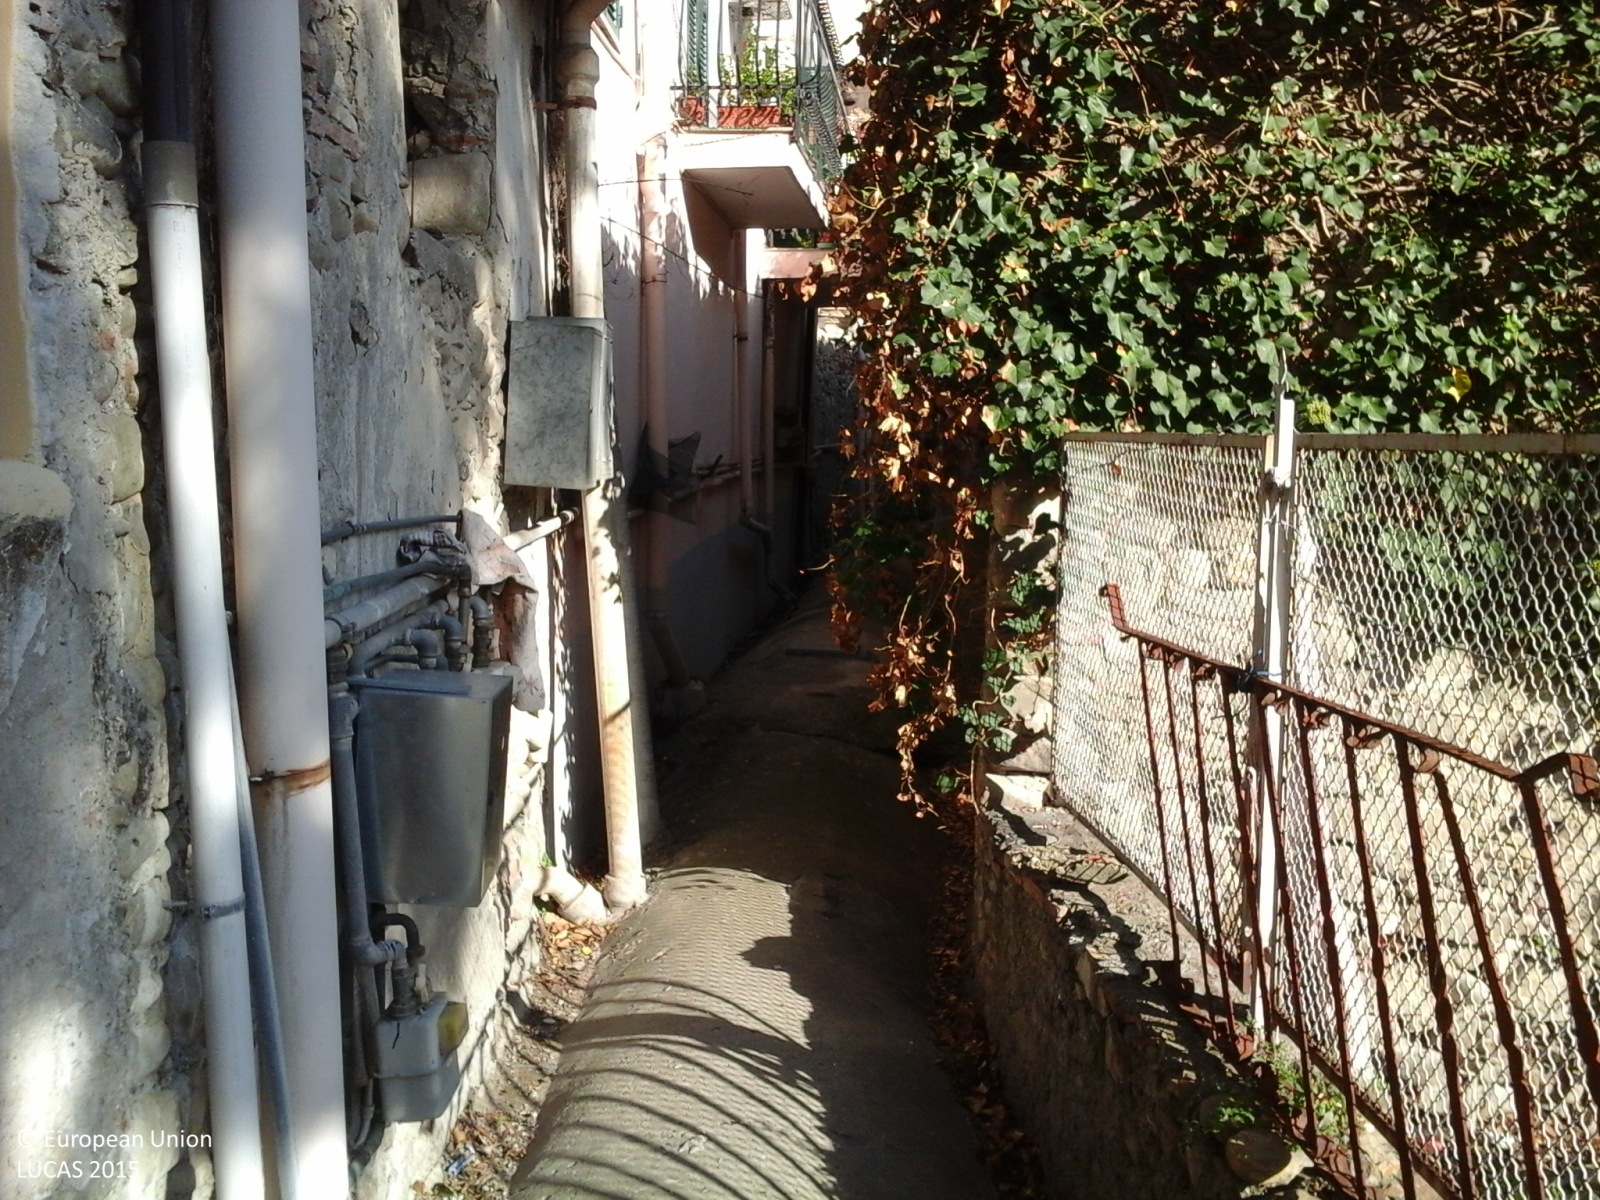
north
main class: Cropland
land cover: Other citrus fruit
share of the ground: 50 - 75 %
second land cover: Grassland without tree/shrub cover
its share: 50 - 75 %
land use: Kitchen garden
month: October
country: IT
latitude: 43.8592
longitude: 7.8529
